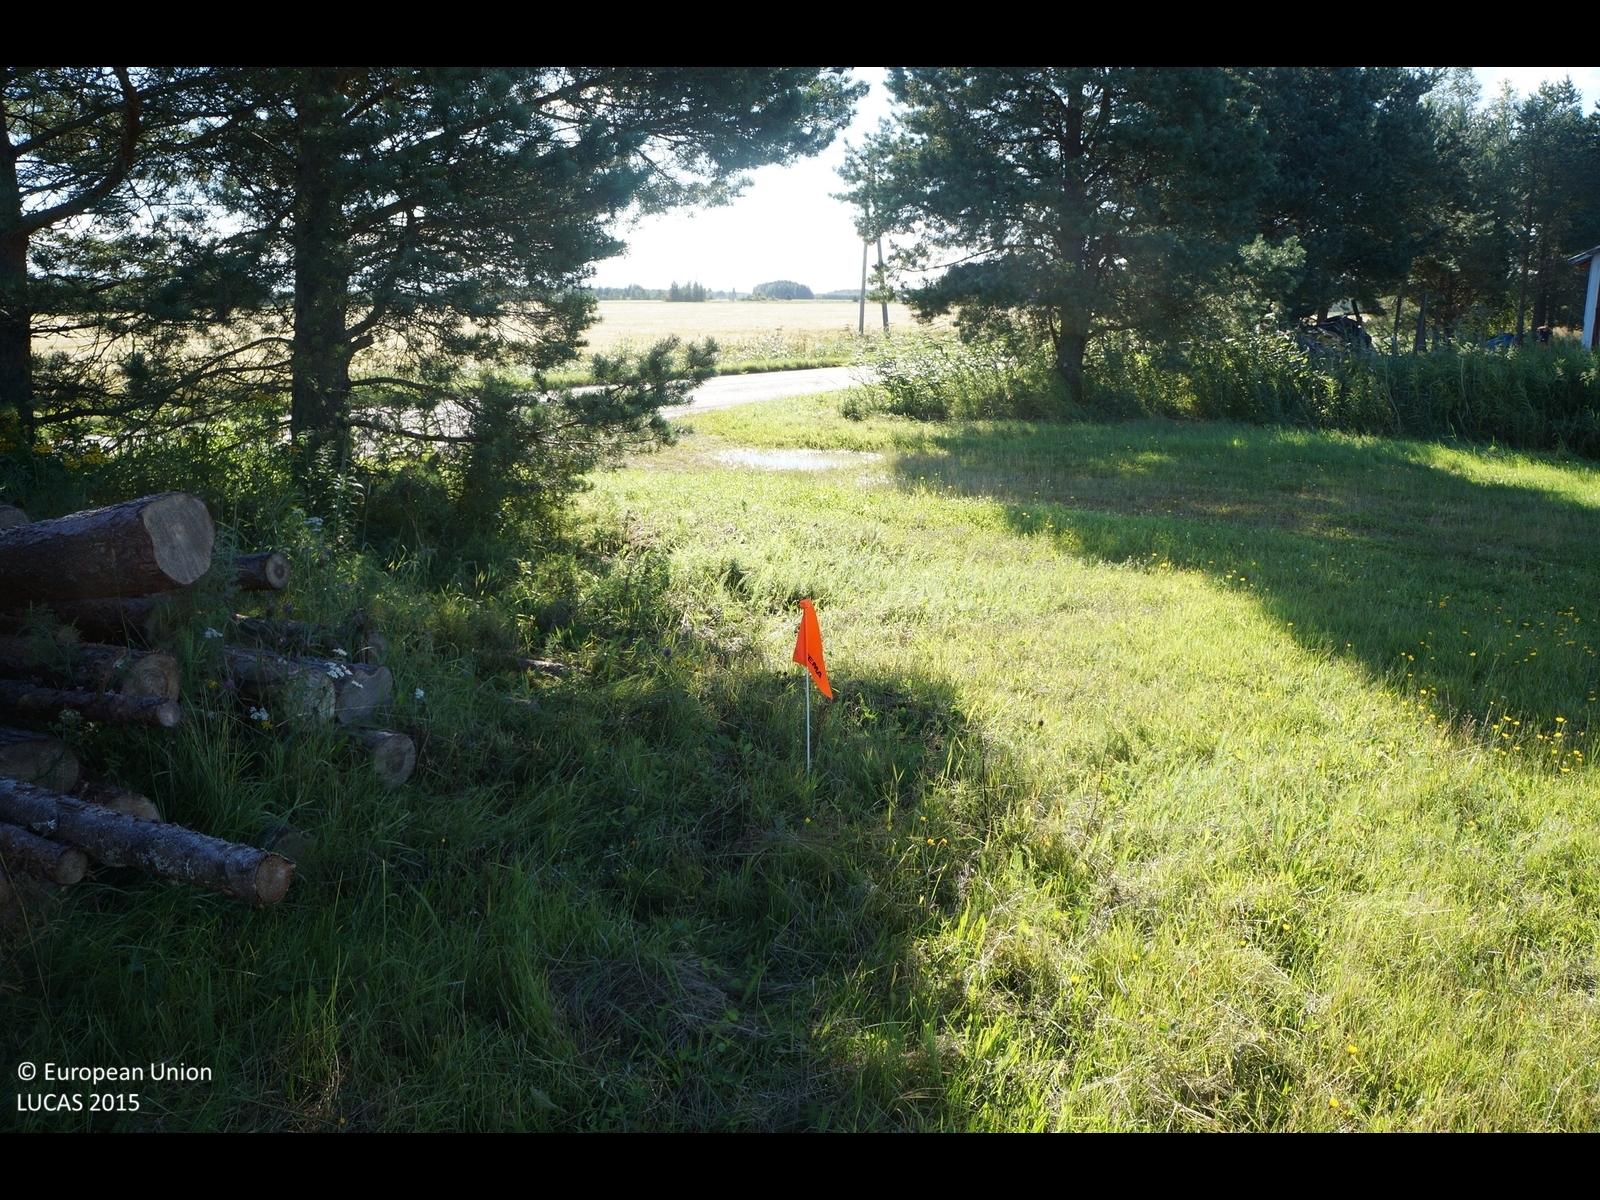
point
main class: Grassland
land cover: Grassland with sparse tree/shrub cover
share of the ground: > 75 %
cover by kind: herbaceous plants 90 %, coniferous forest trees 5 %, shrubs 5 %
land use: Agriculture (excluding fallow land and kitchen gardens)
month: August
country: FI
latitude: 64.7975
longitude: 25.4714
